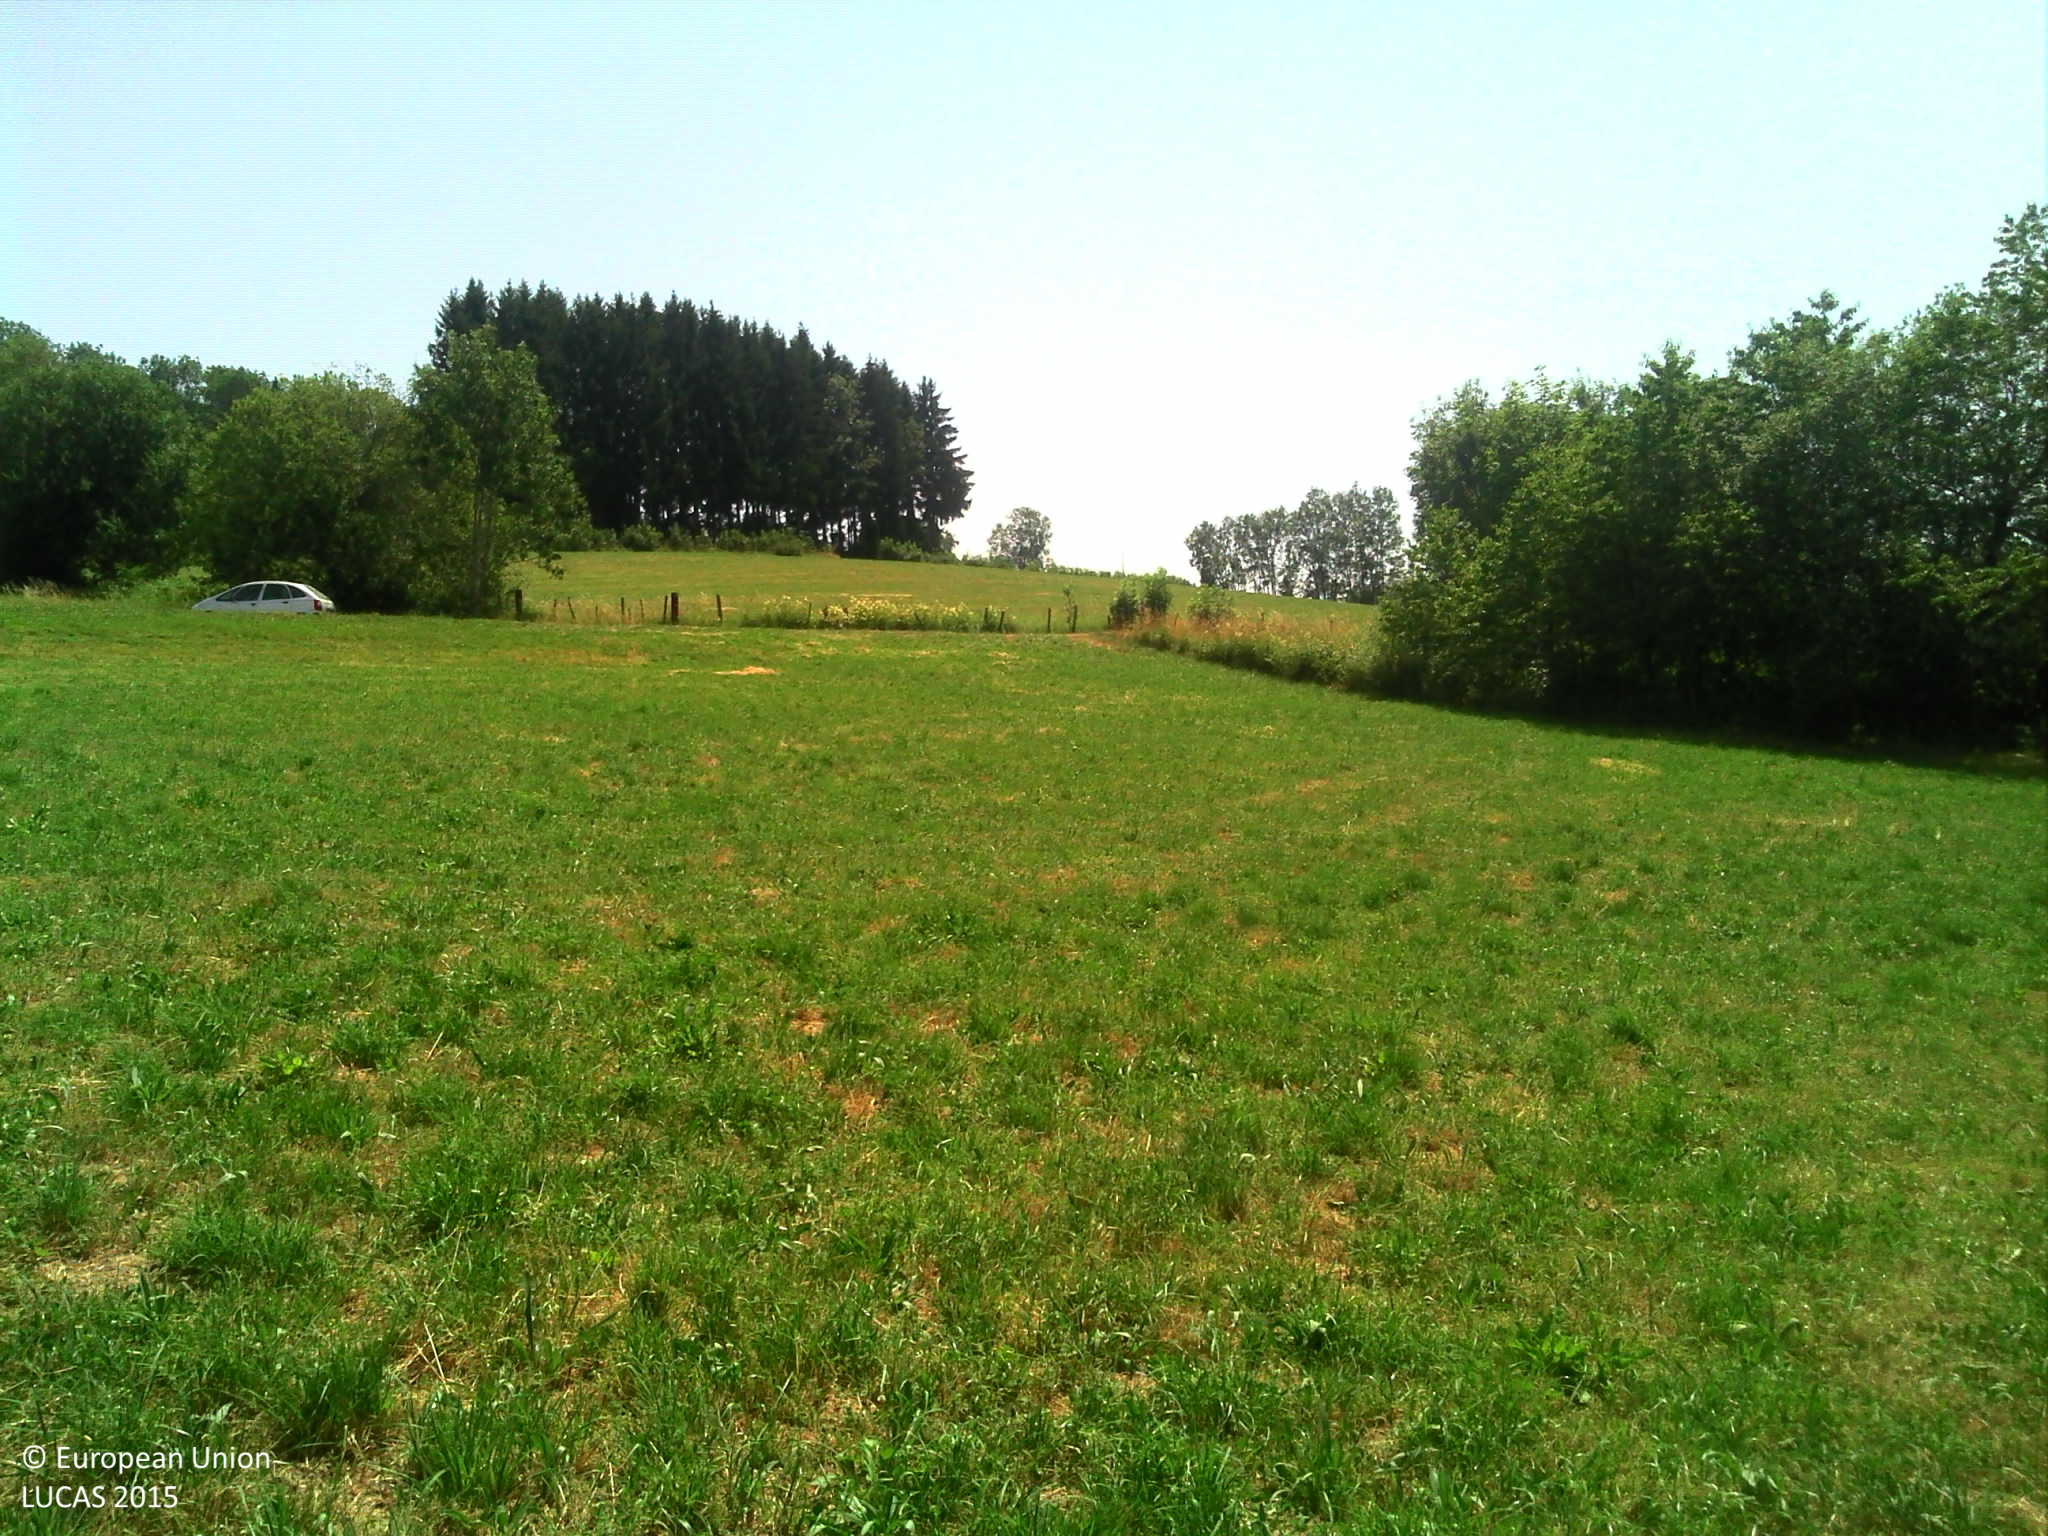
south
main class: Grassland
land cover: Grassland without tree/shrub cover
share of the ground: > 75 %
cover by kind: herbaceous plants 100 %
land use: Agriculture (excluding fallow land and kitchen gardens)
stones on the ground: < 10 %
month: July
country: FR
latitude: 46.0850
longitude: 6.1886
